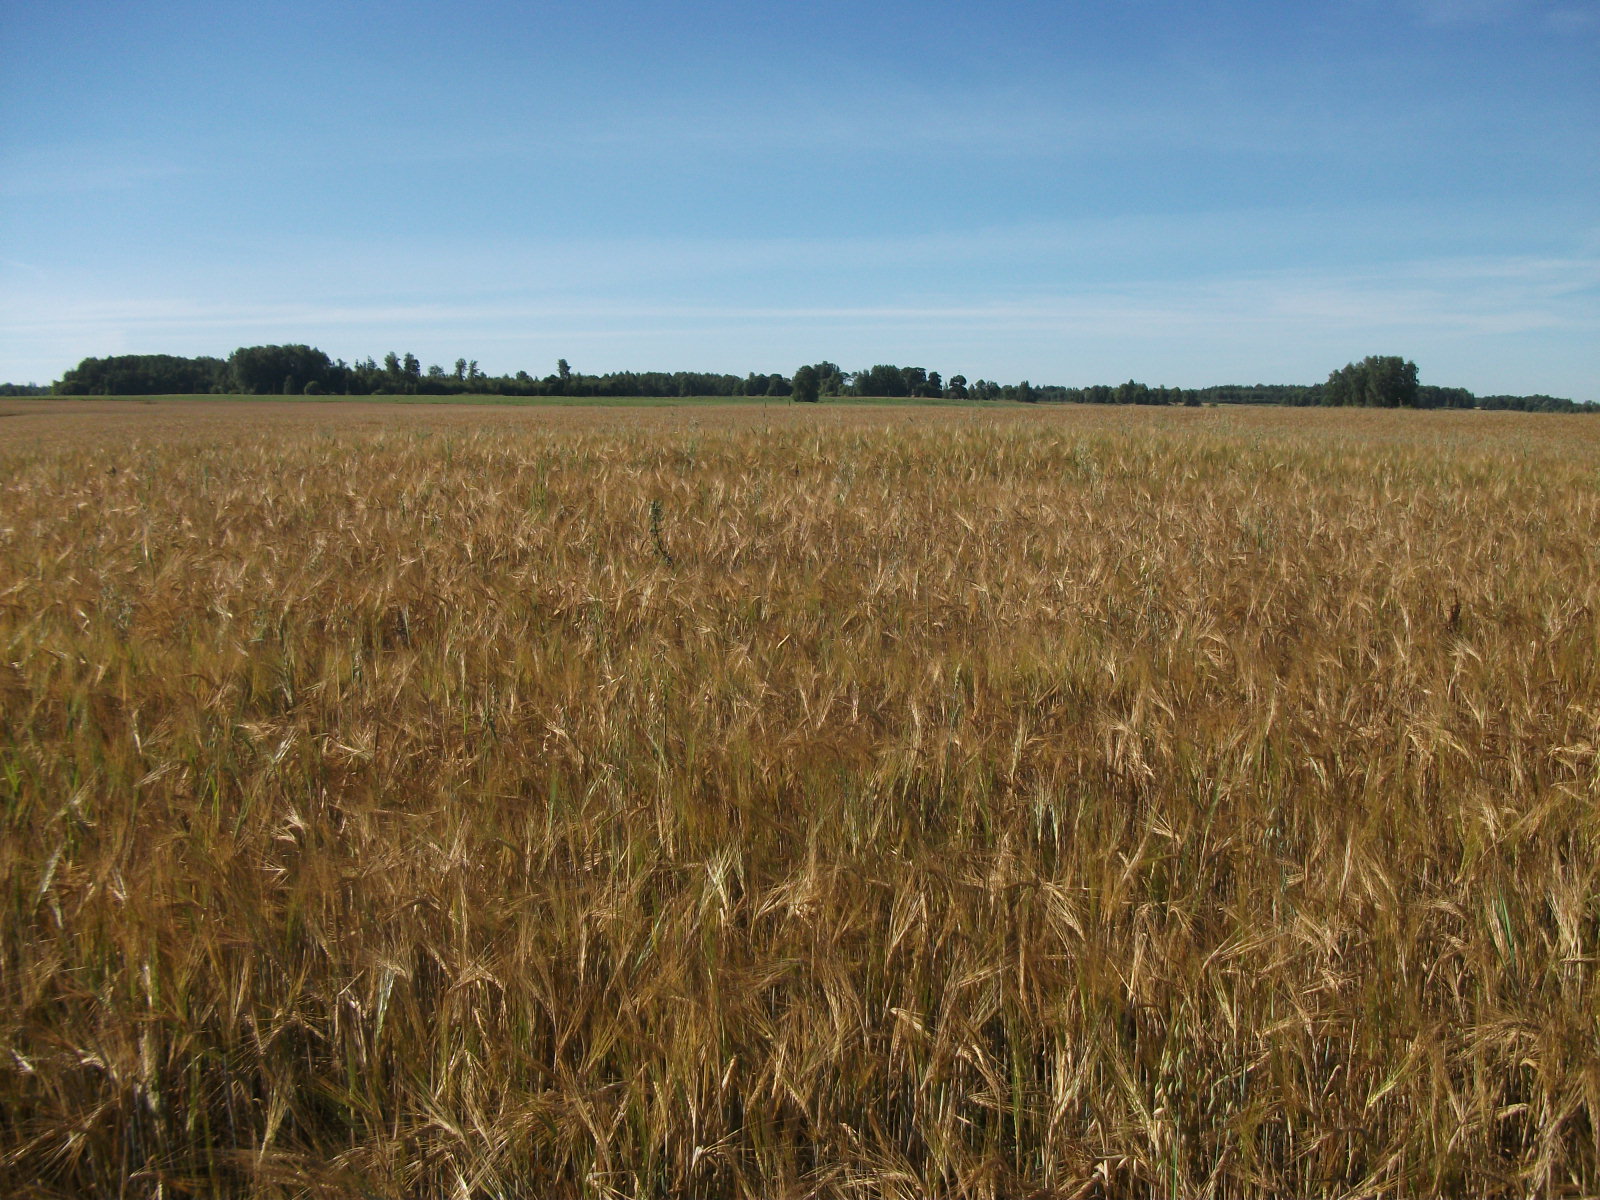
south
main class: Cropland
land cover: Barley
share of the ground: > 75 %
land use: Agriculture (excluding fallow land and kitchen gardens)
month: August
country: LV
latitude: 56.7128
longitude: 26.3319
